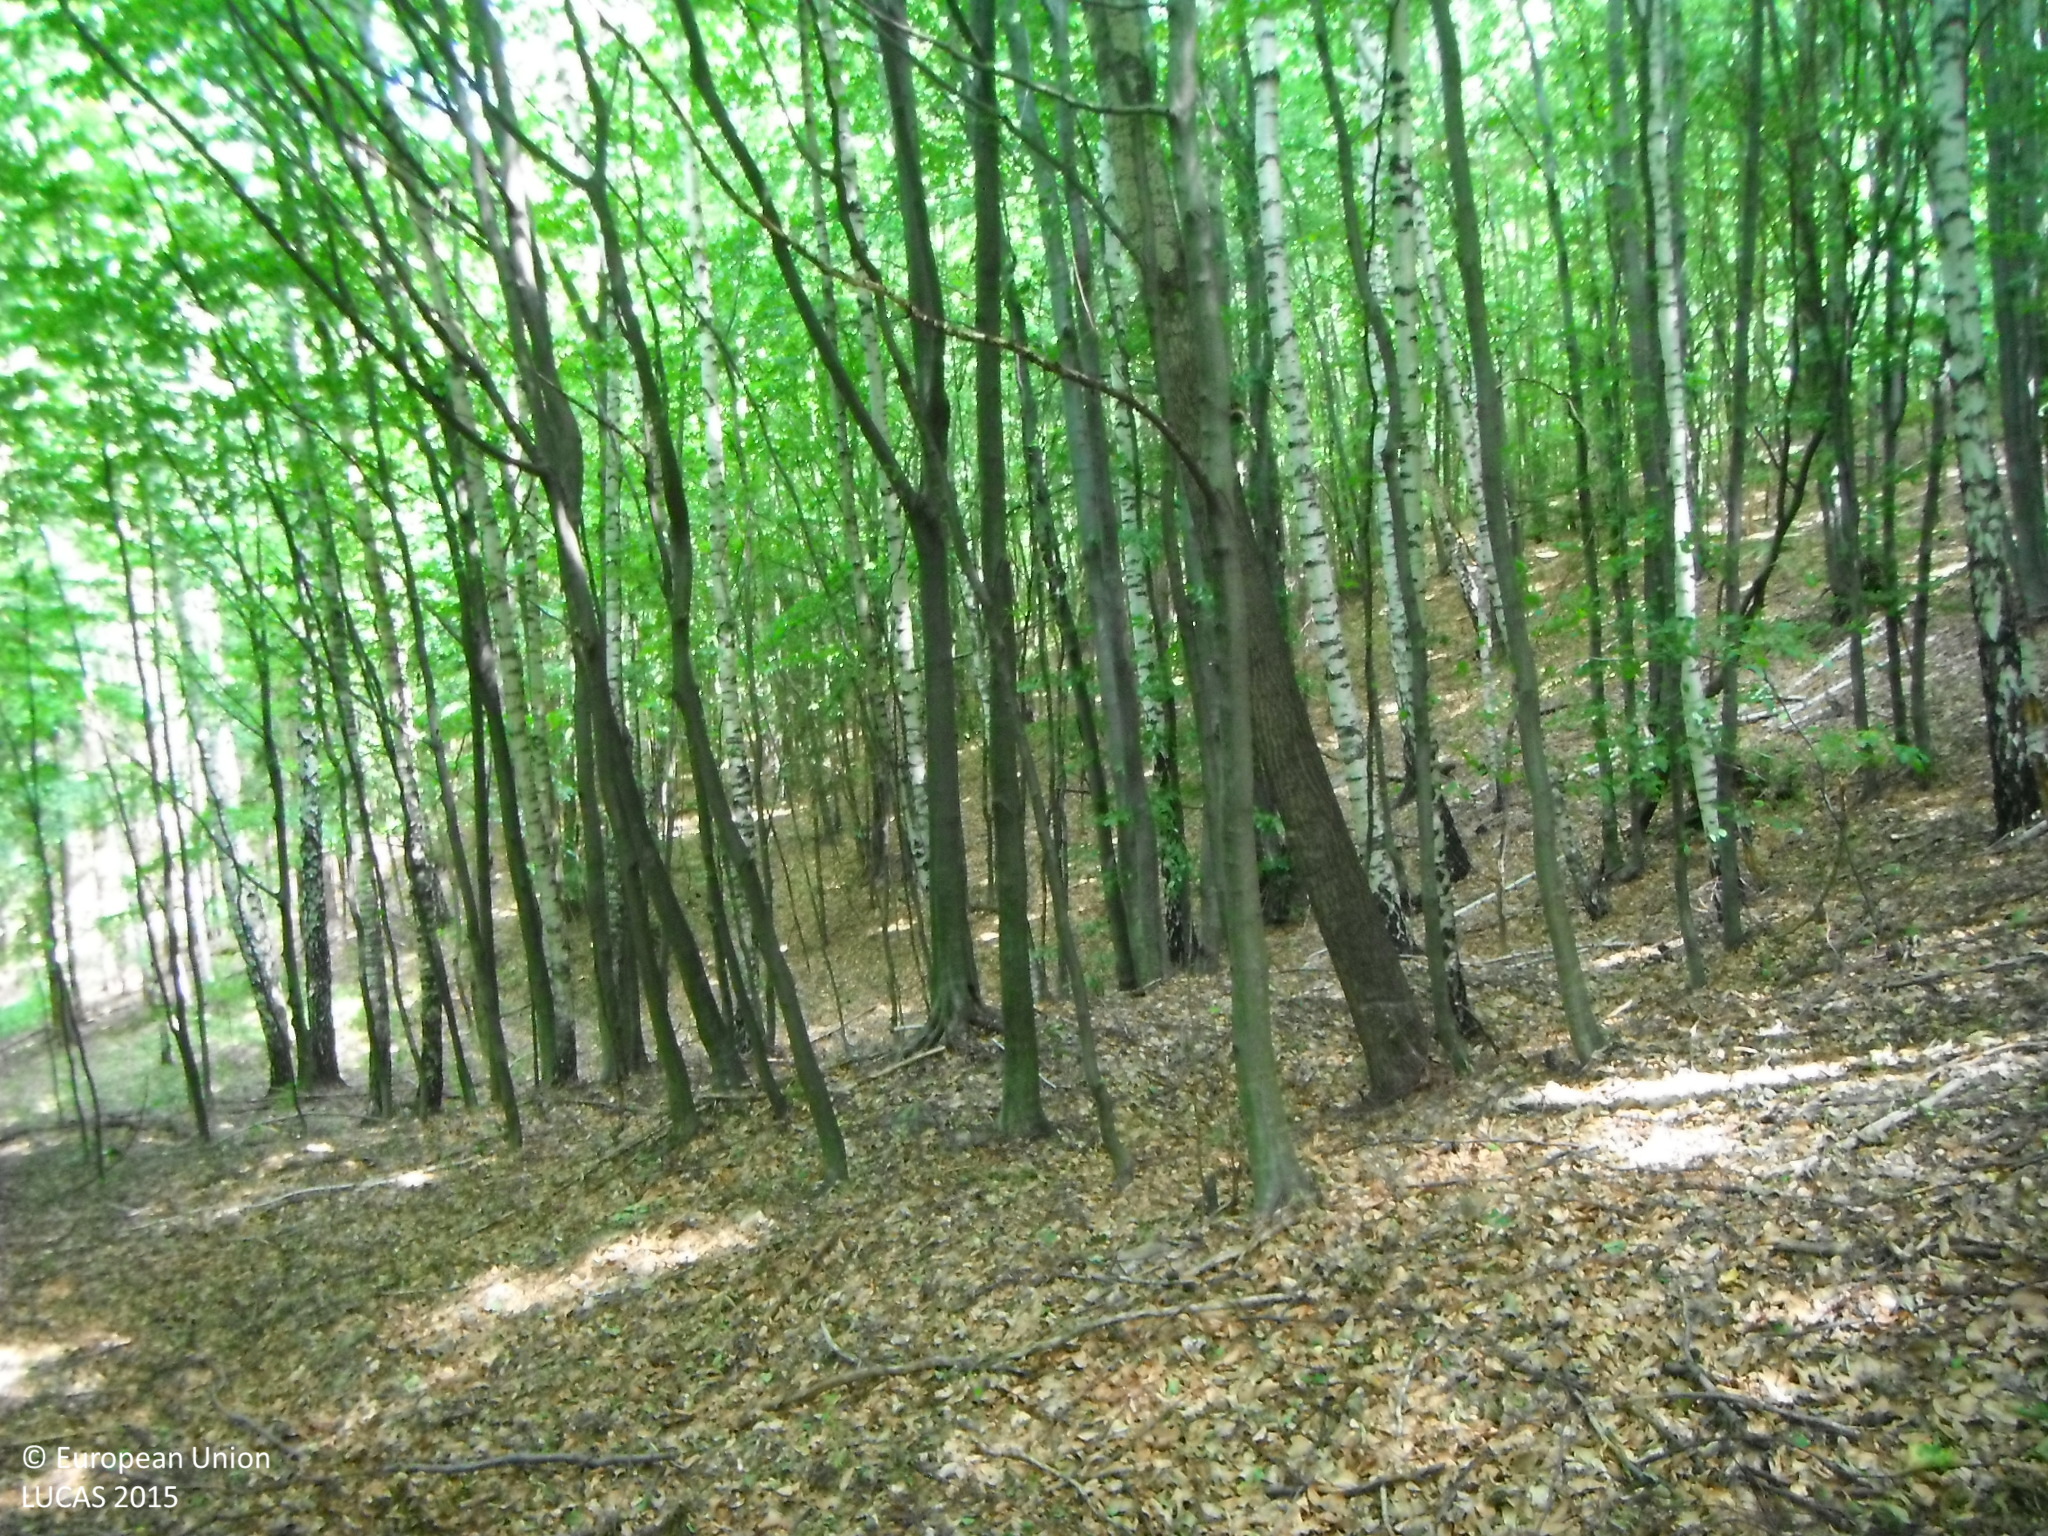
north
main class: Woodland
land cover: Broadleaved woodland
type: beech forest
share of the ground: > 75 %
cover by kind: broadleaved forest trees 100 %
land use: Forestry
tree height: > 5 m
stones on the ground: > 50 %
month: July
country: SK
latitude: 48.7394
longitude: 20.0798
